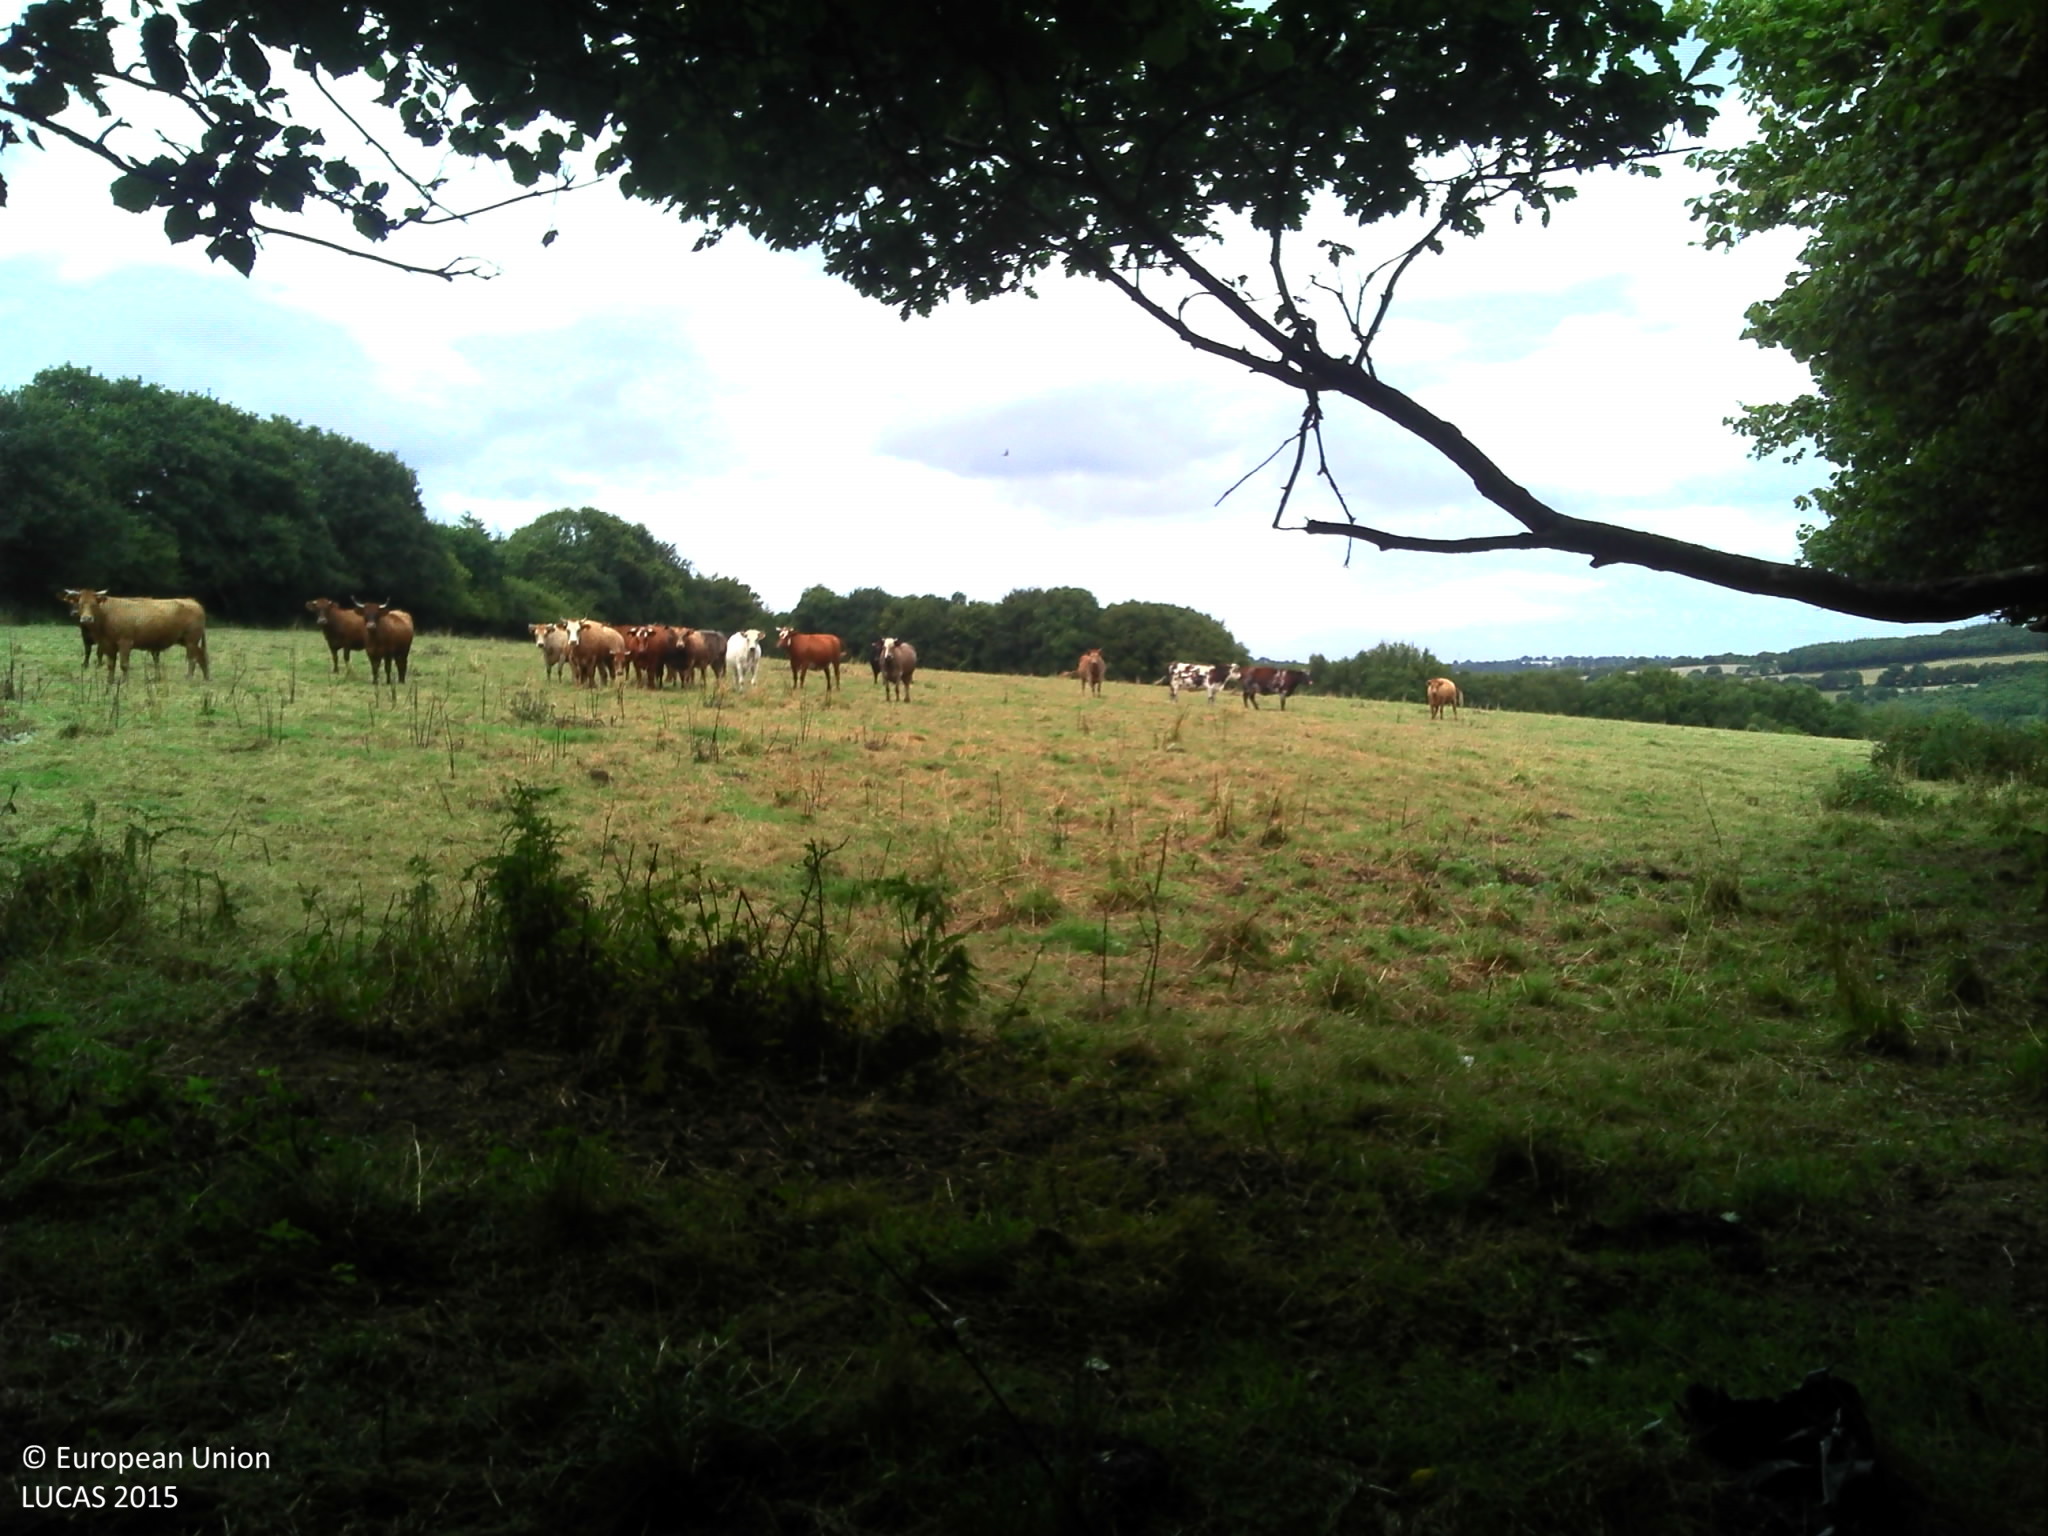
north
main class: Grassland
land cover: Grassland without tree/shrub cover
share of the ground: > 75 %
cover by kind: herbaceous plants 100 %
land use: Agriculture (excluding fallow land and kitchen gardens)
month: August
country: FR
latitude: 48.4140
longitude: -3.4673
